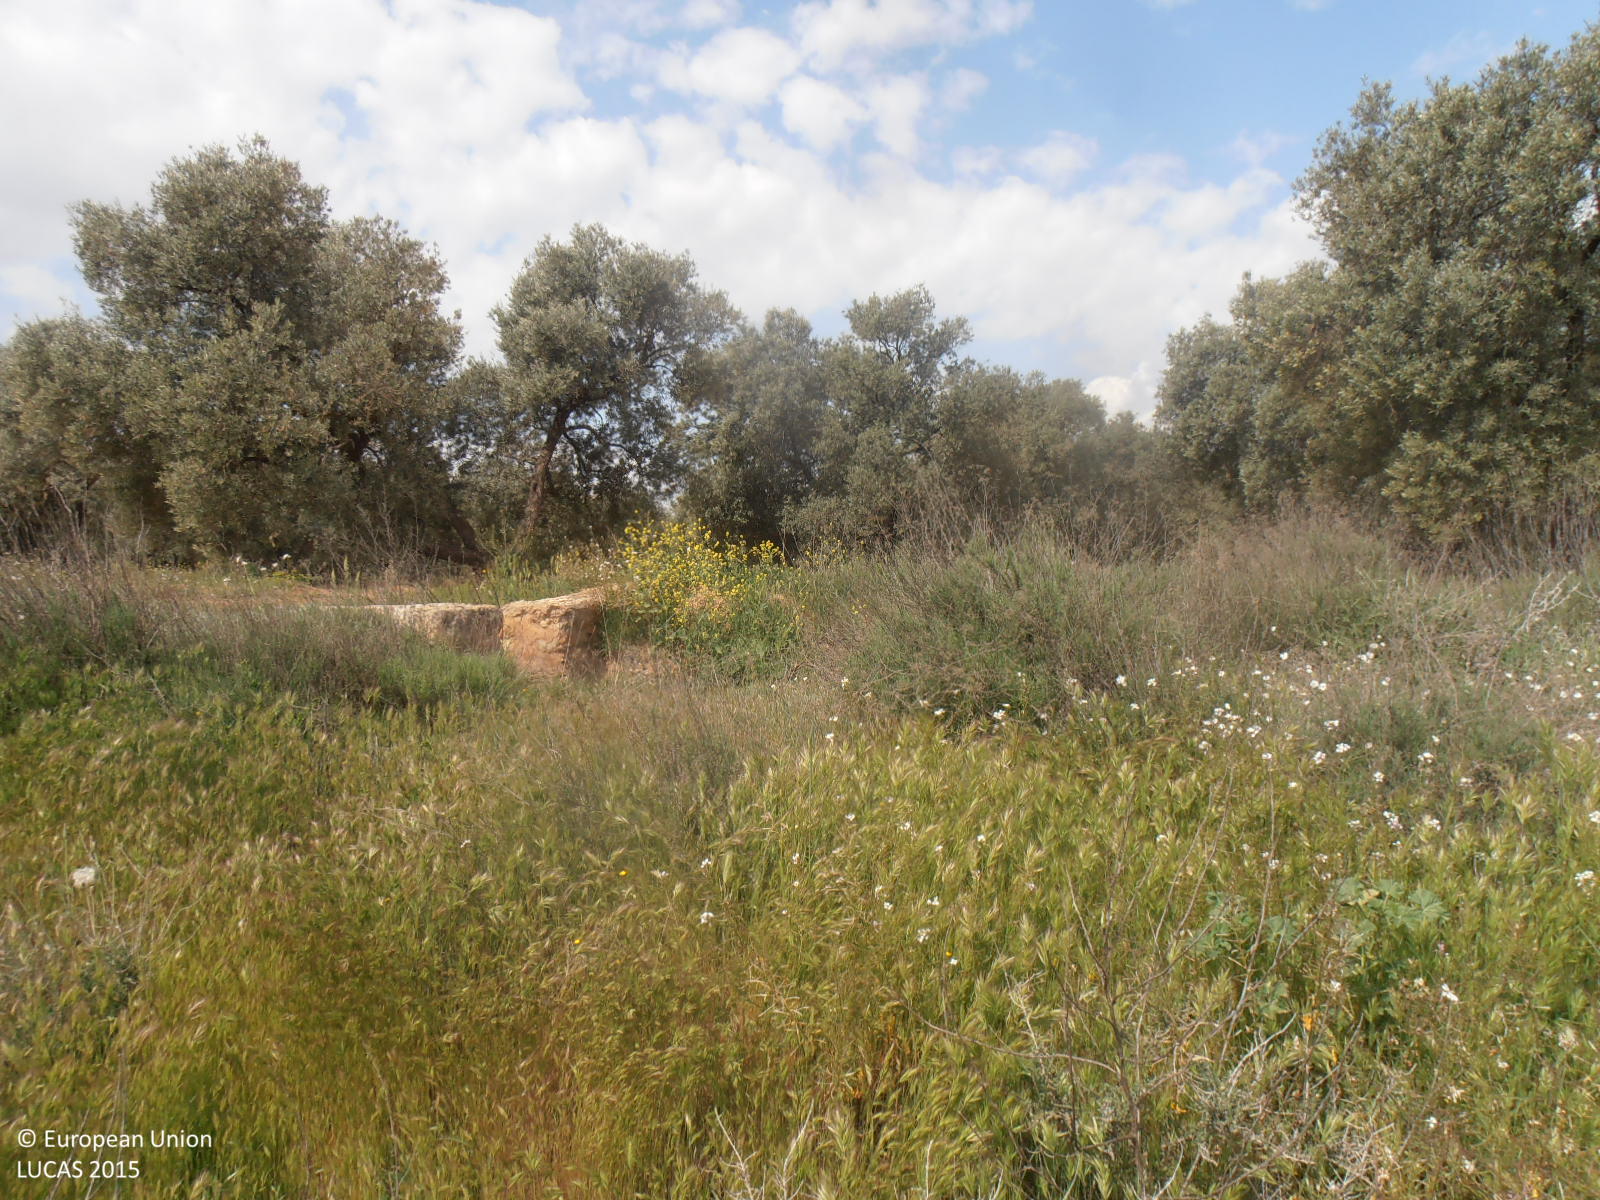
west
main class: Grassland
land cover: Grassland with sparse tree/shrub cover
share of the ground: > 75 %
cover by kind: herbaceous plants 90 %, broadleaved forest trees 5 %, shrubs 5 %
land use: Abandoned areas
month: April
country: ES
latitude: 41.3172
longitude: -0.7331
